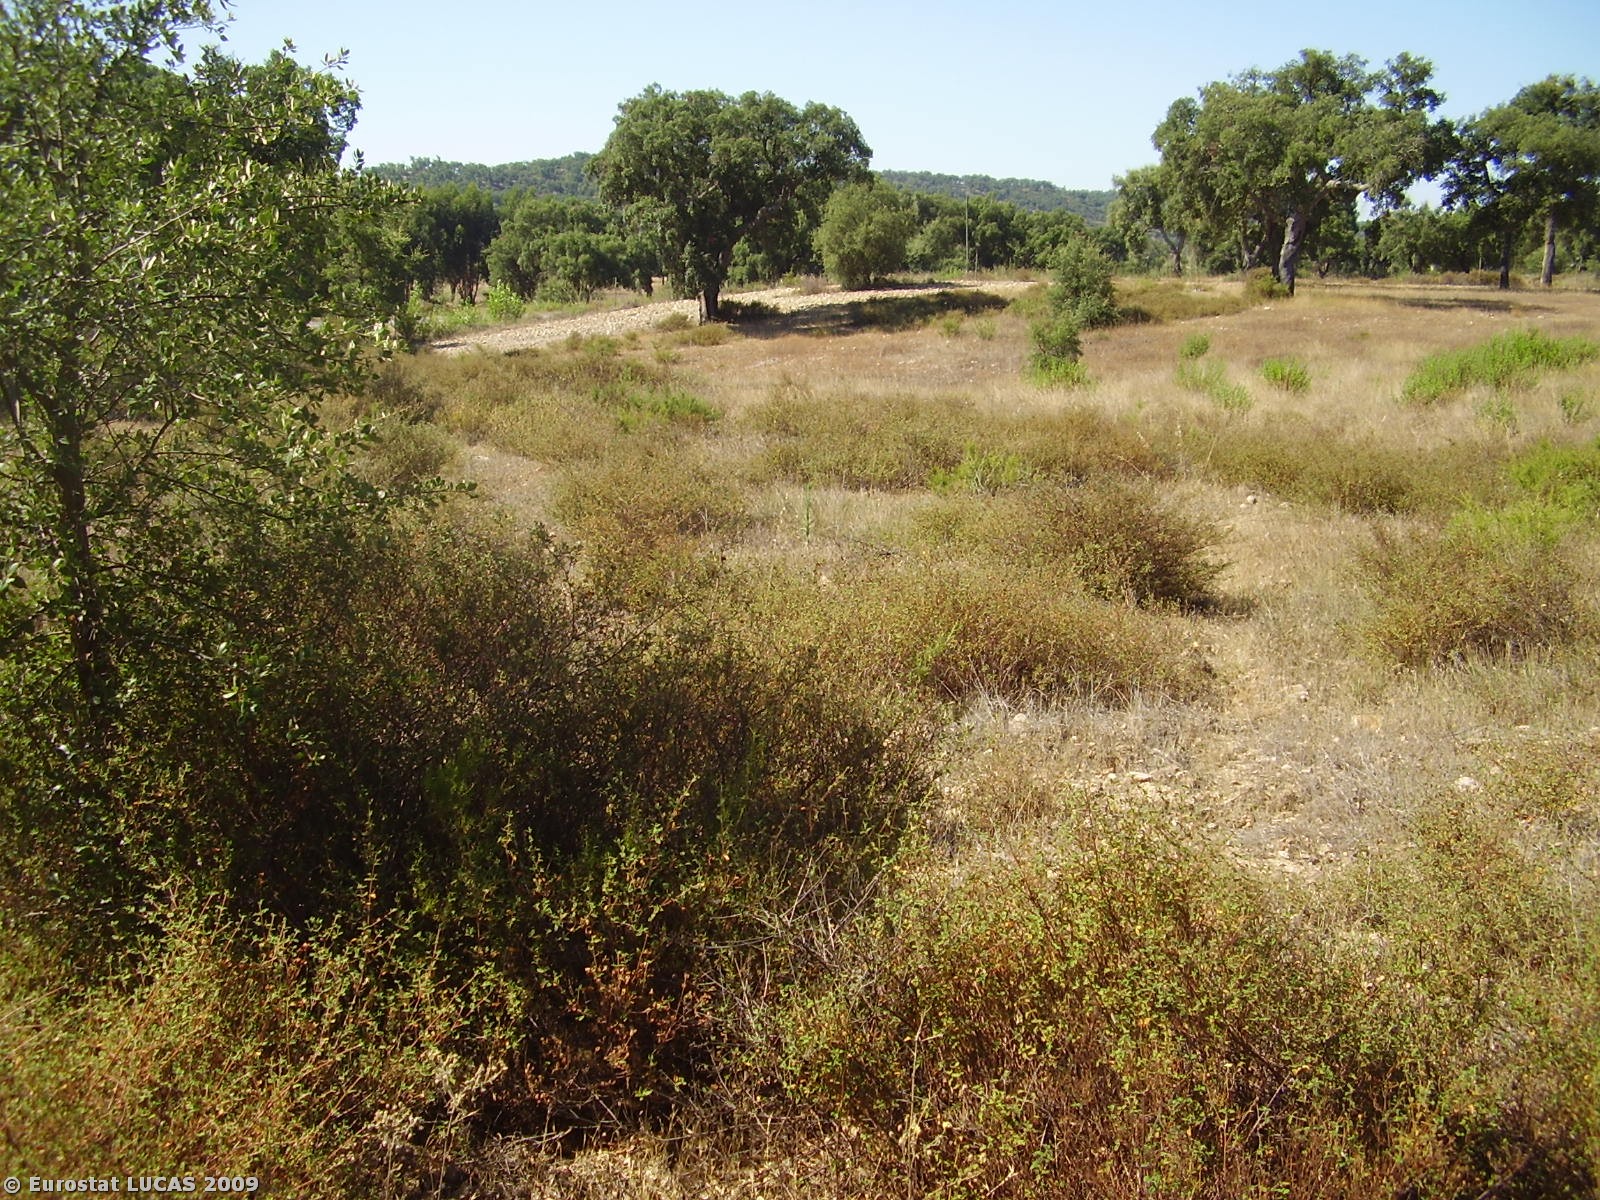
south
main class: Woodland
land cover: Broadleaved woodland
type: broadleaved evergreen forest
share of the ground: < 10 %
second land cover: Spontaneously vegetated surfaces
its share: > 75 %
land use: Forestry
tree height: > 5 m
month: July
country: PT
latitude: 39.3530
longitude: -8.1519
